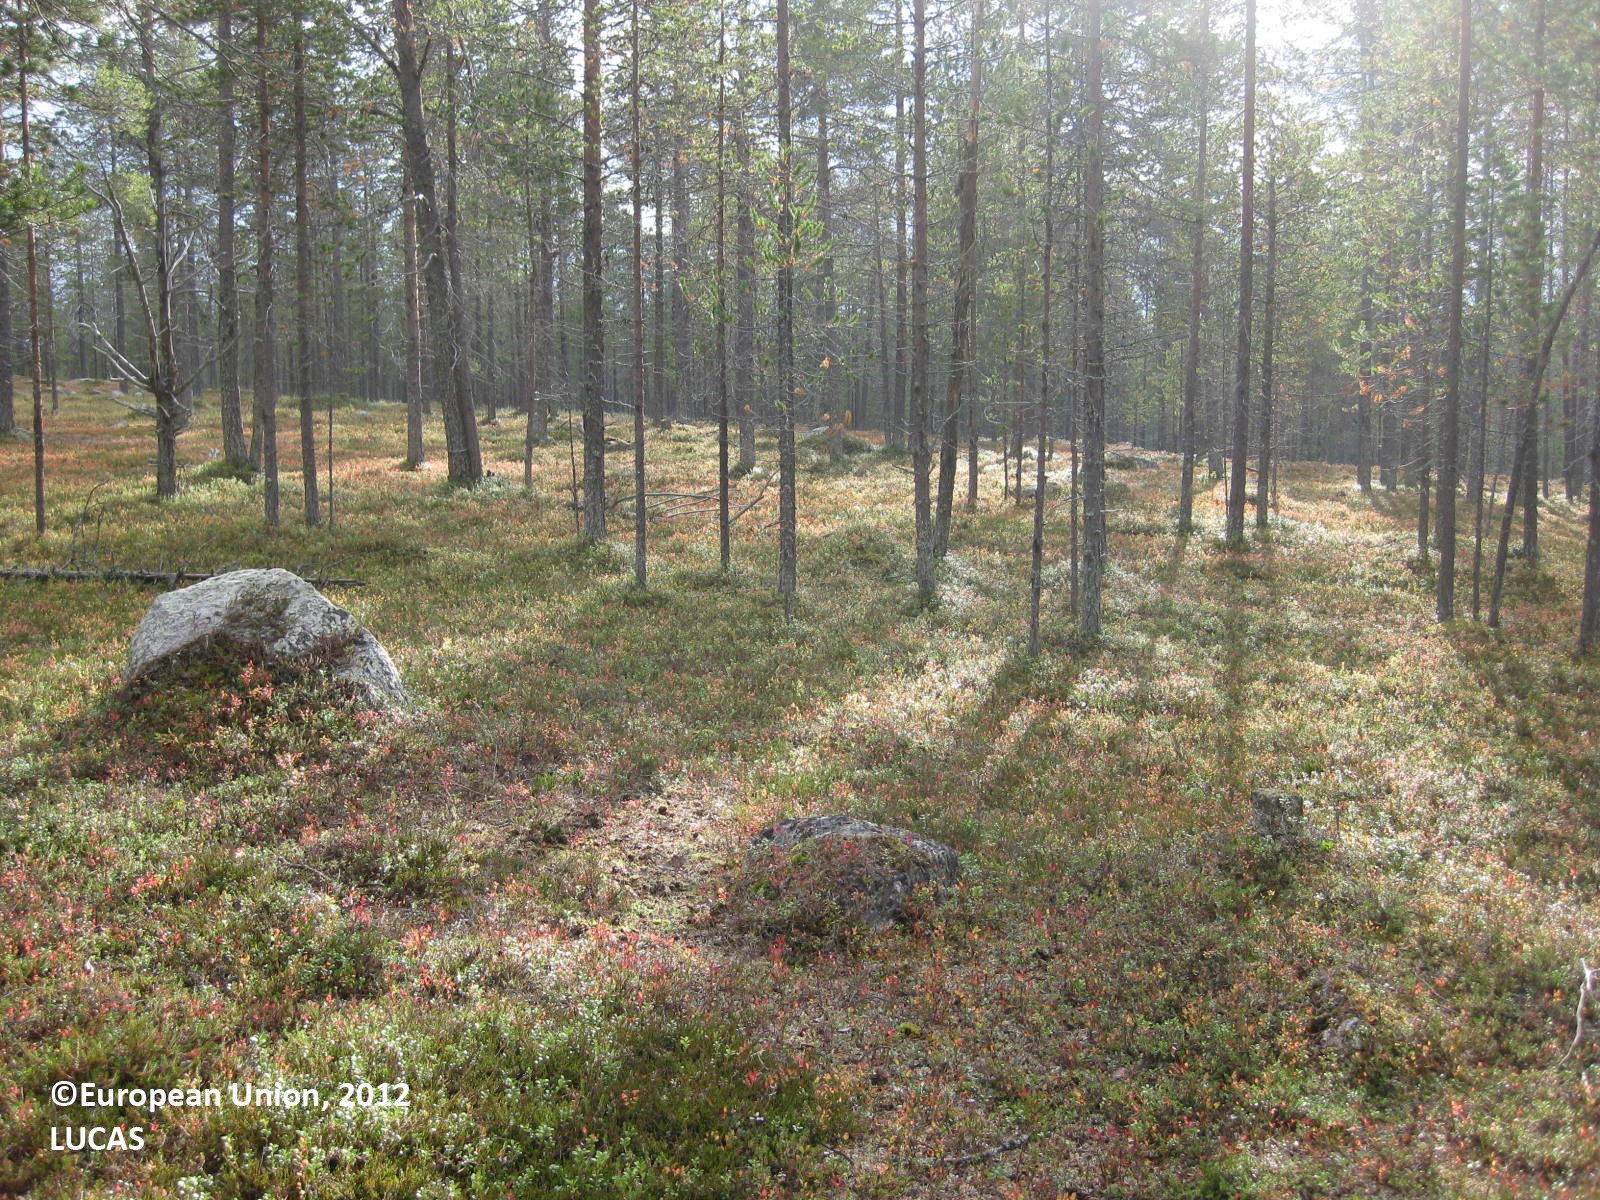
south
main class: Woodland
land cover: Pine dominated coniferous woodland
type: boreal forest
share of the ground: > 75 %
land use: Forestry
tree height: > 5 m
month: September
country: FI
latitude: 68.0120
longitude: 23.5801
